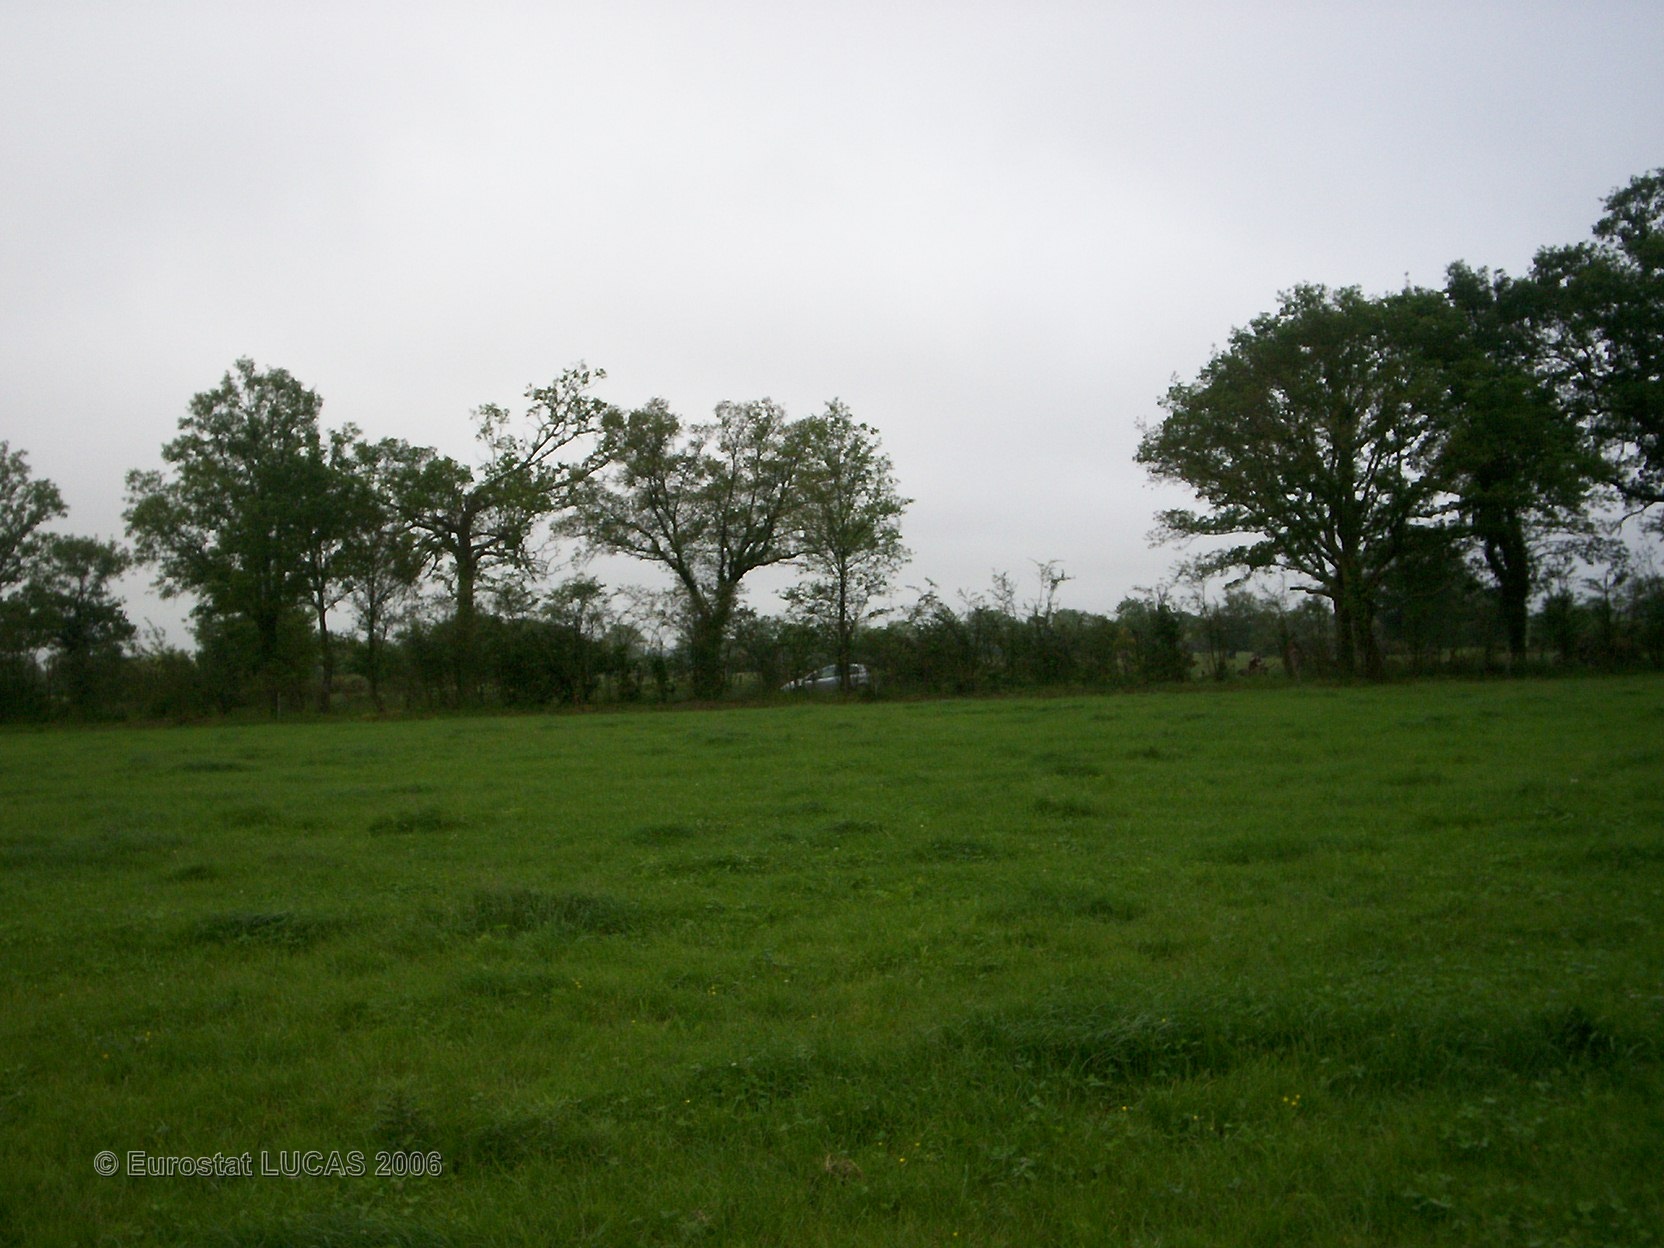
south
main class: Grassland
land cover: Grassland without tree/shrub cover
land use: Agriculture (excluding fallow land and kitchen gardens)
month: May
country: FR
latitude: 47.5486
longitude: -1.4833
